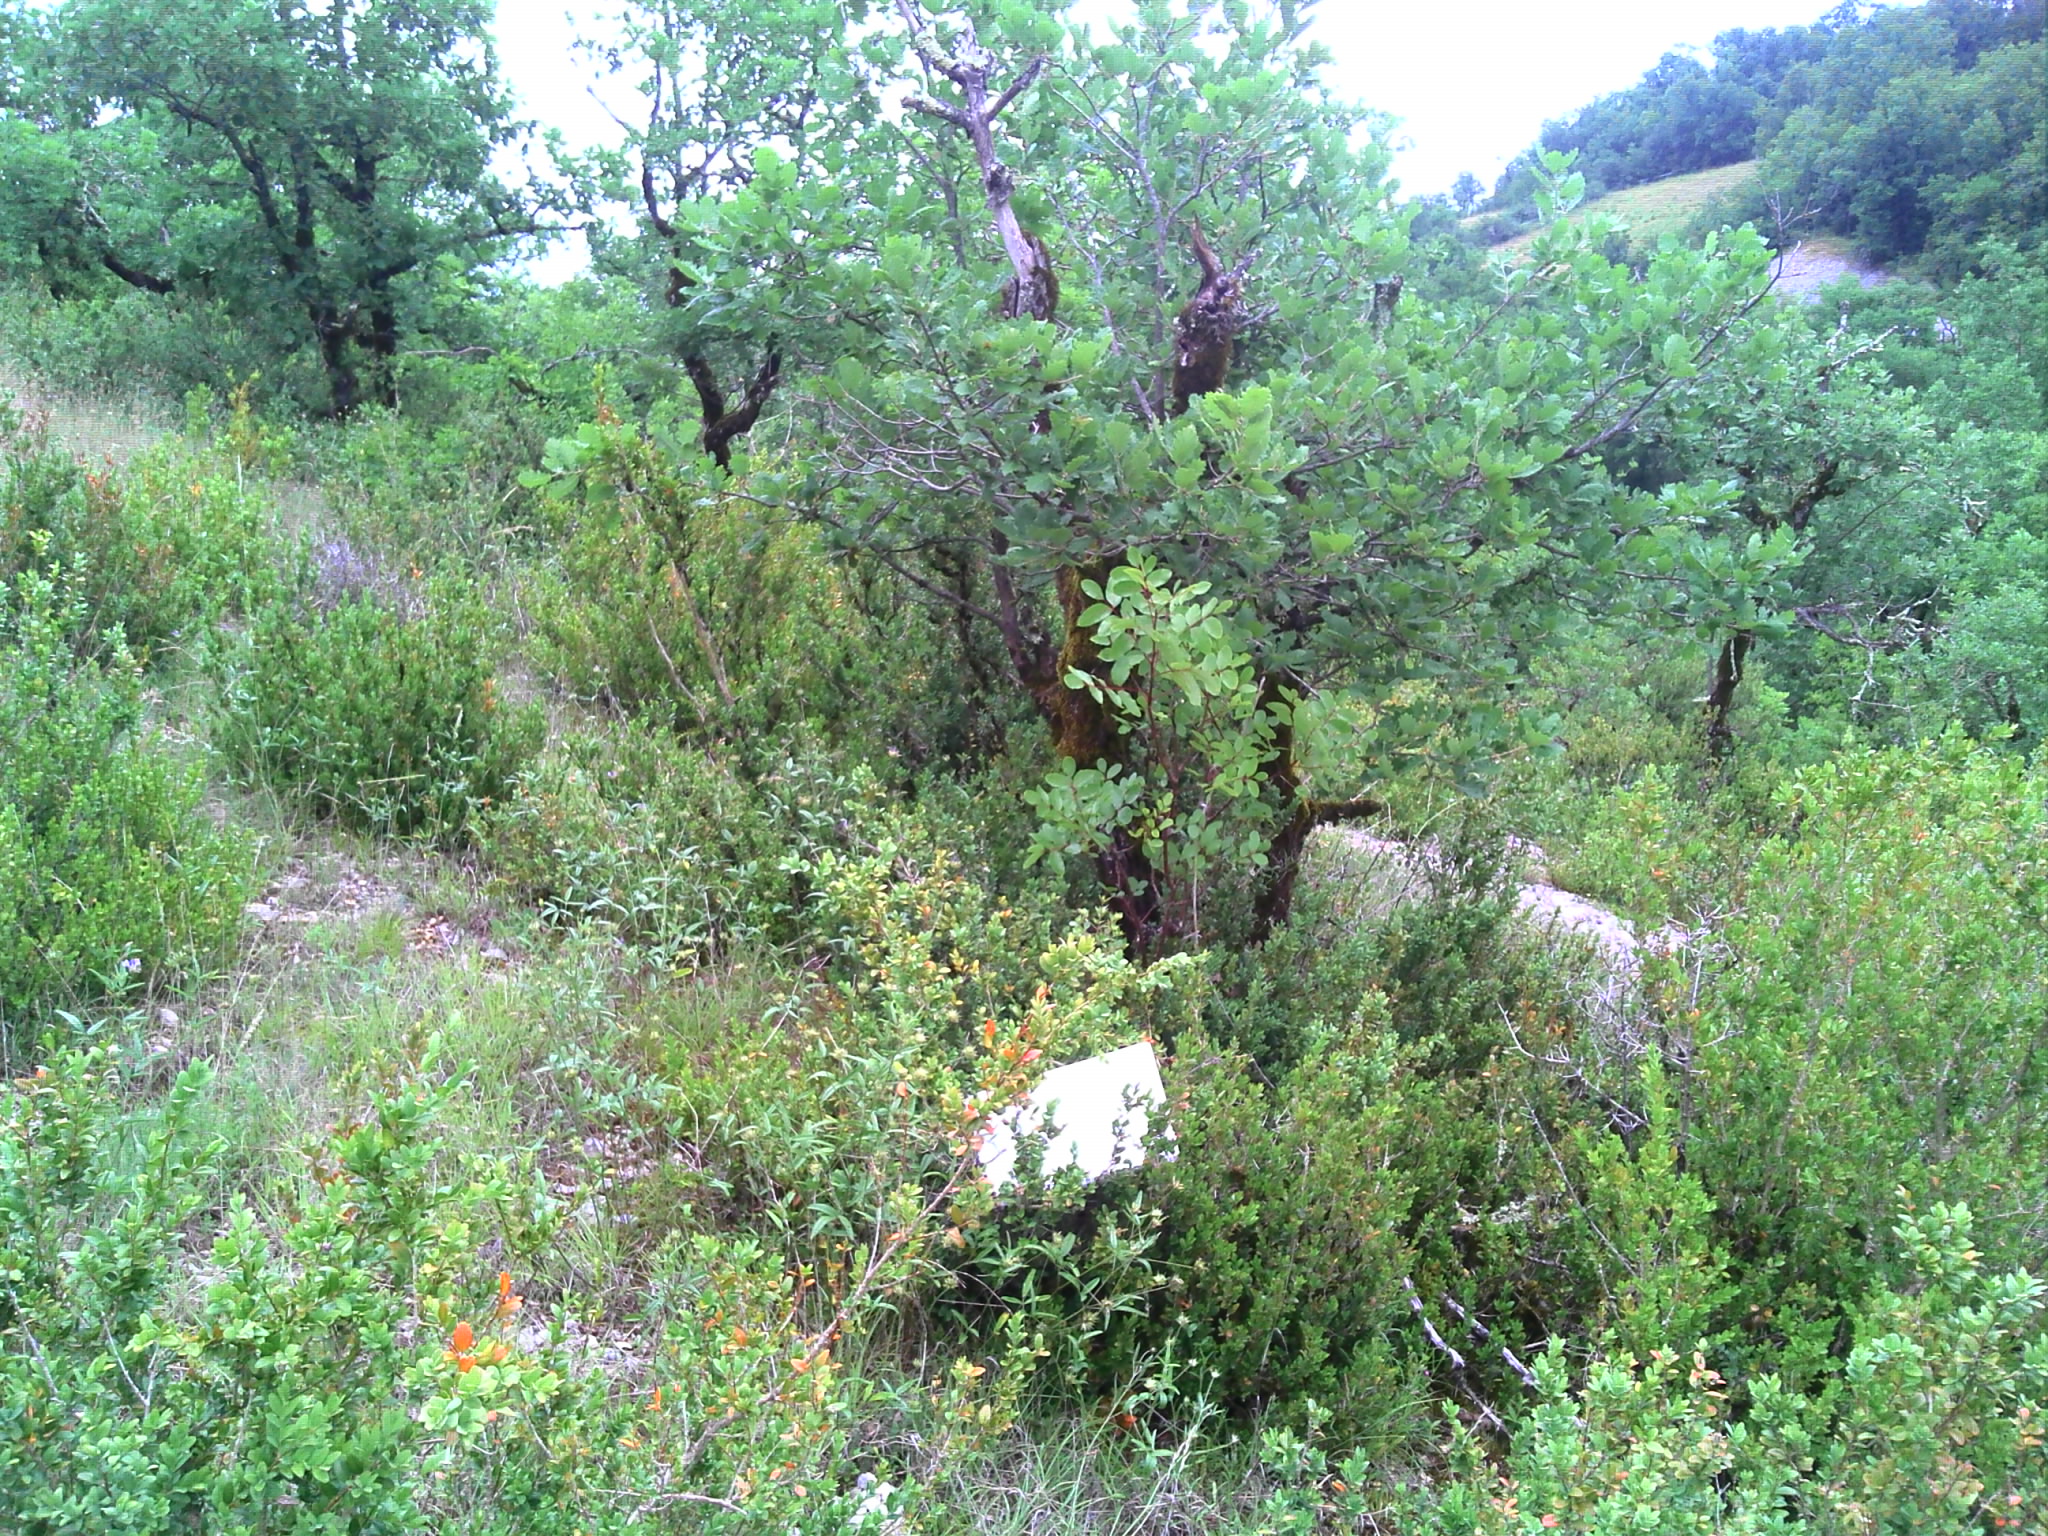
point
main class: Woodland
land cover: Broadleaved woodland
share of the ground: > 75 %
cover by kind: broadleaved forest trees 95 %, herbaceous plants 5 %
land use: Semi-natural and natural areas not in use
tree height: < 5 m
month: June
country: FR
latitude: 44.4378
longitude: 1.5182
